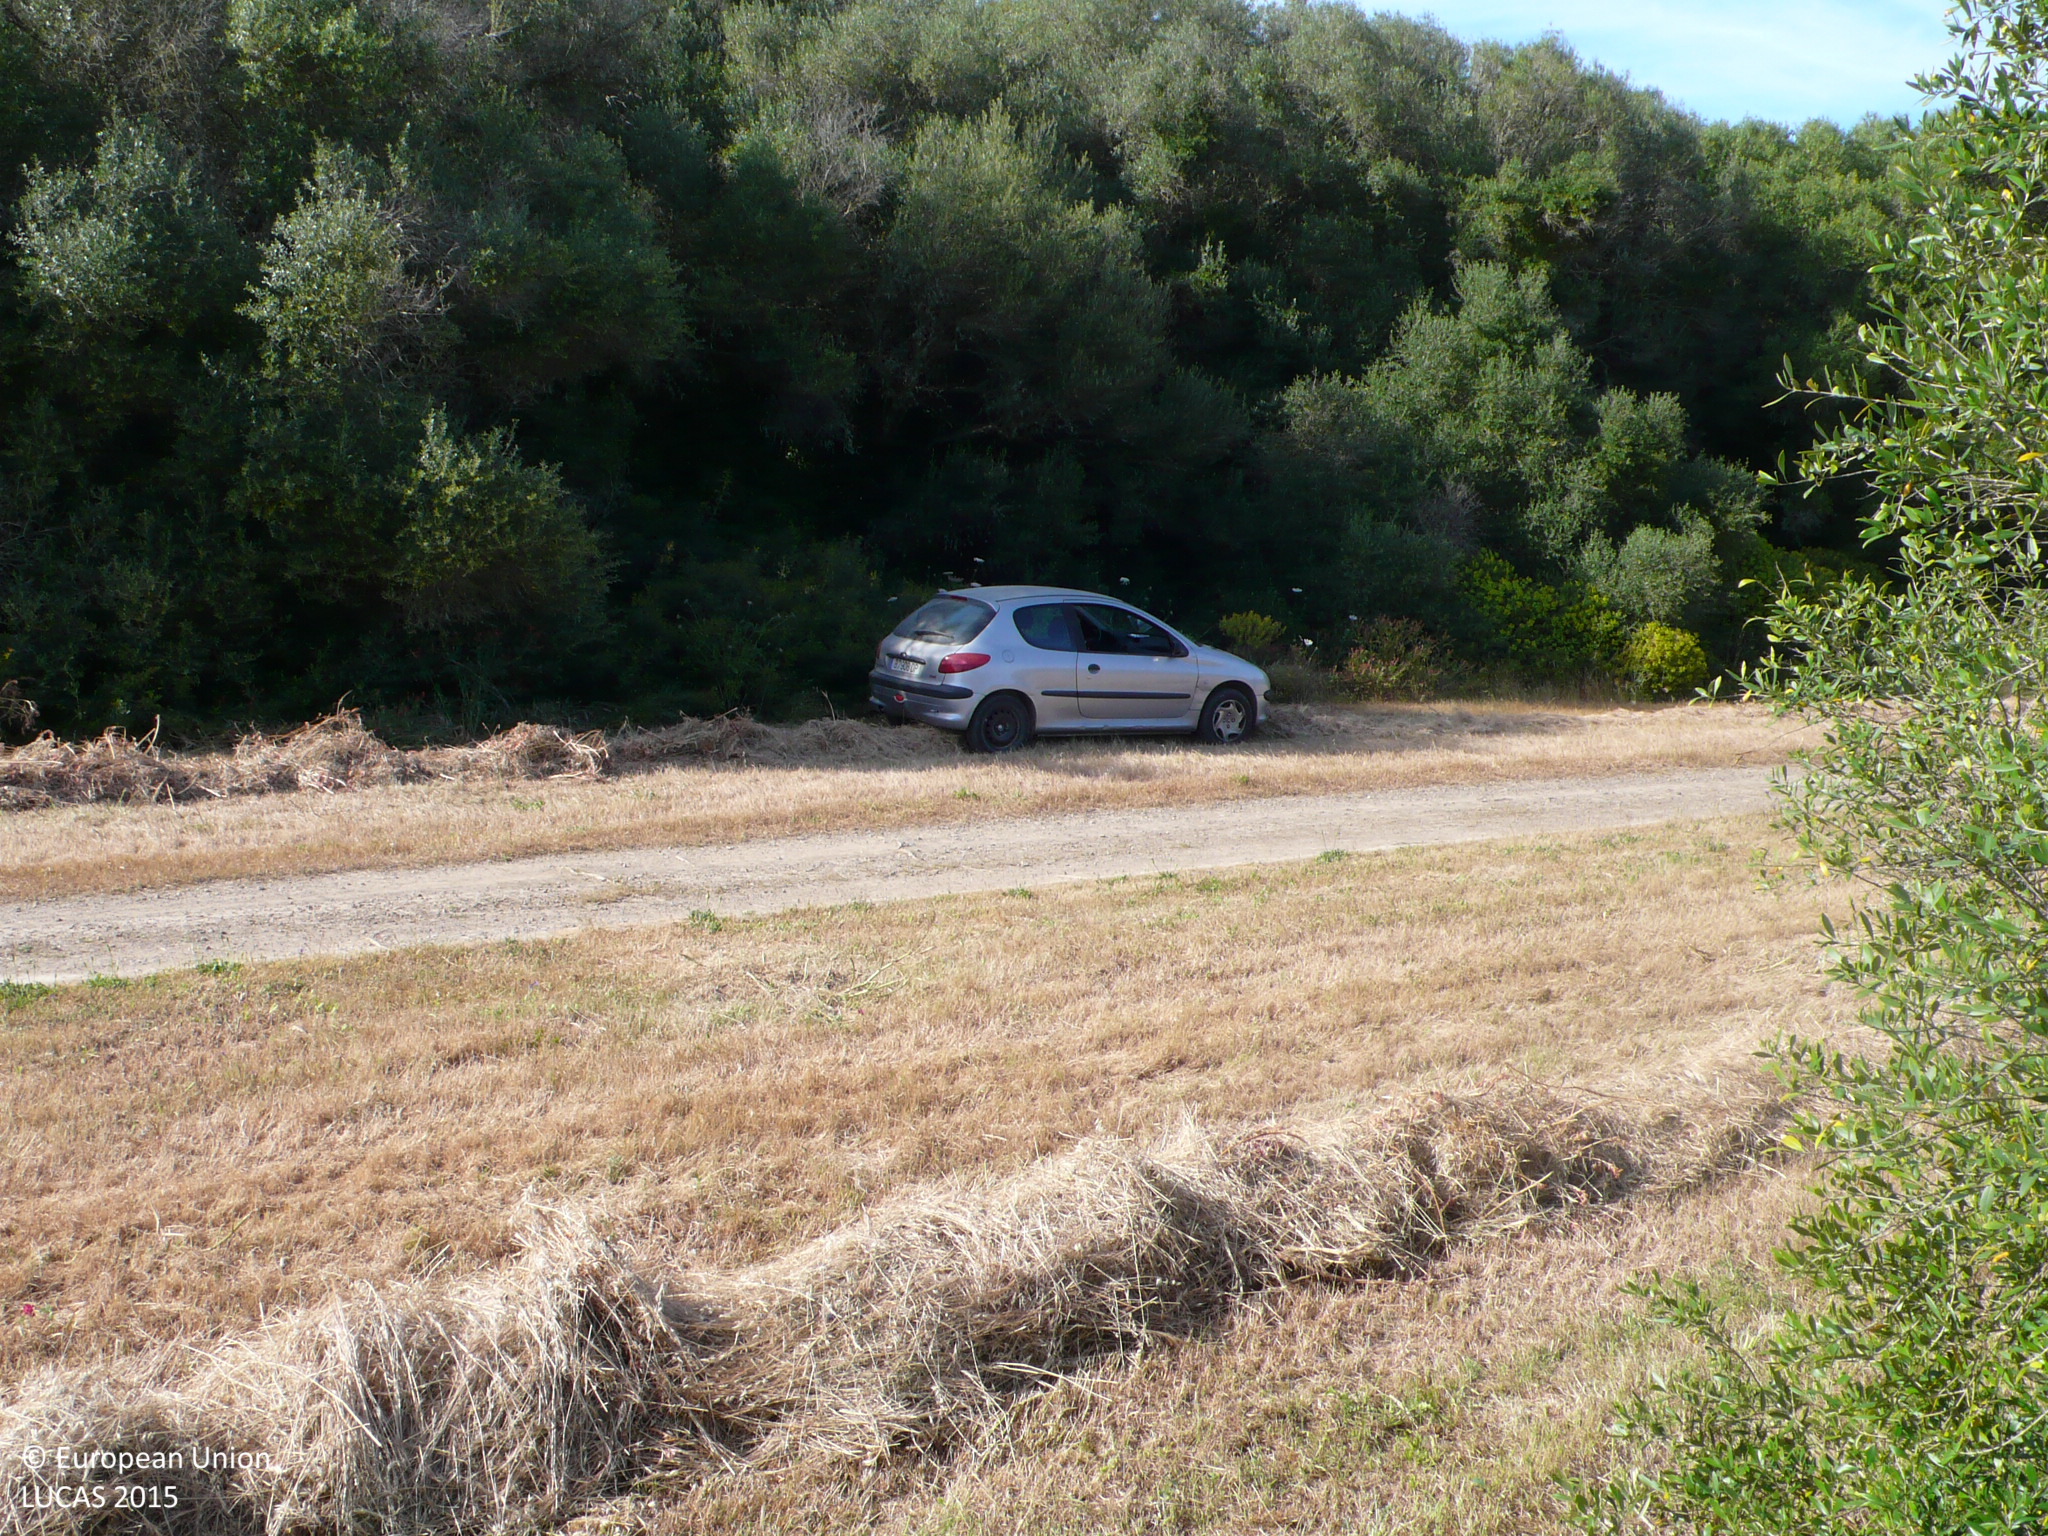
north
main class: Cropland
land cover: Mixed cereals for fodder
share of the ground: < 10 %
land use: Agriculture (excluding fallow land and kitchen gardens)
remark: Harvested field
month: May
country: ES
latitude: 39.9357
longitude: 4.2566
